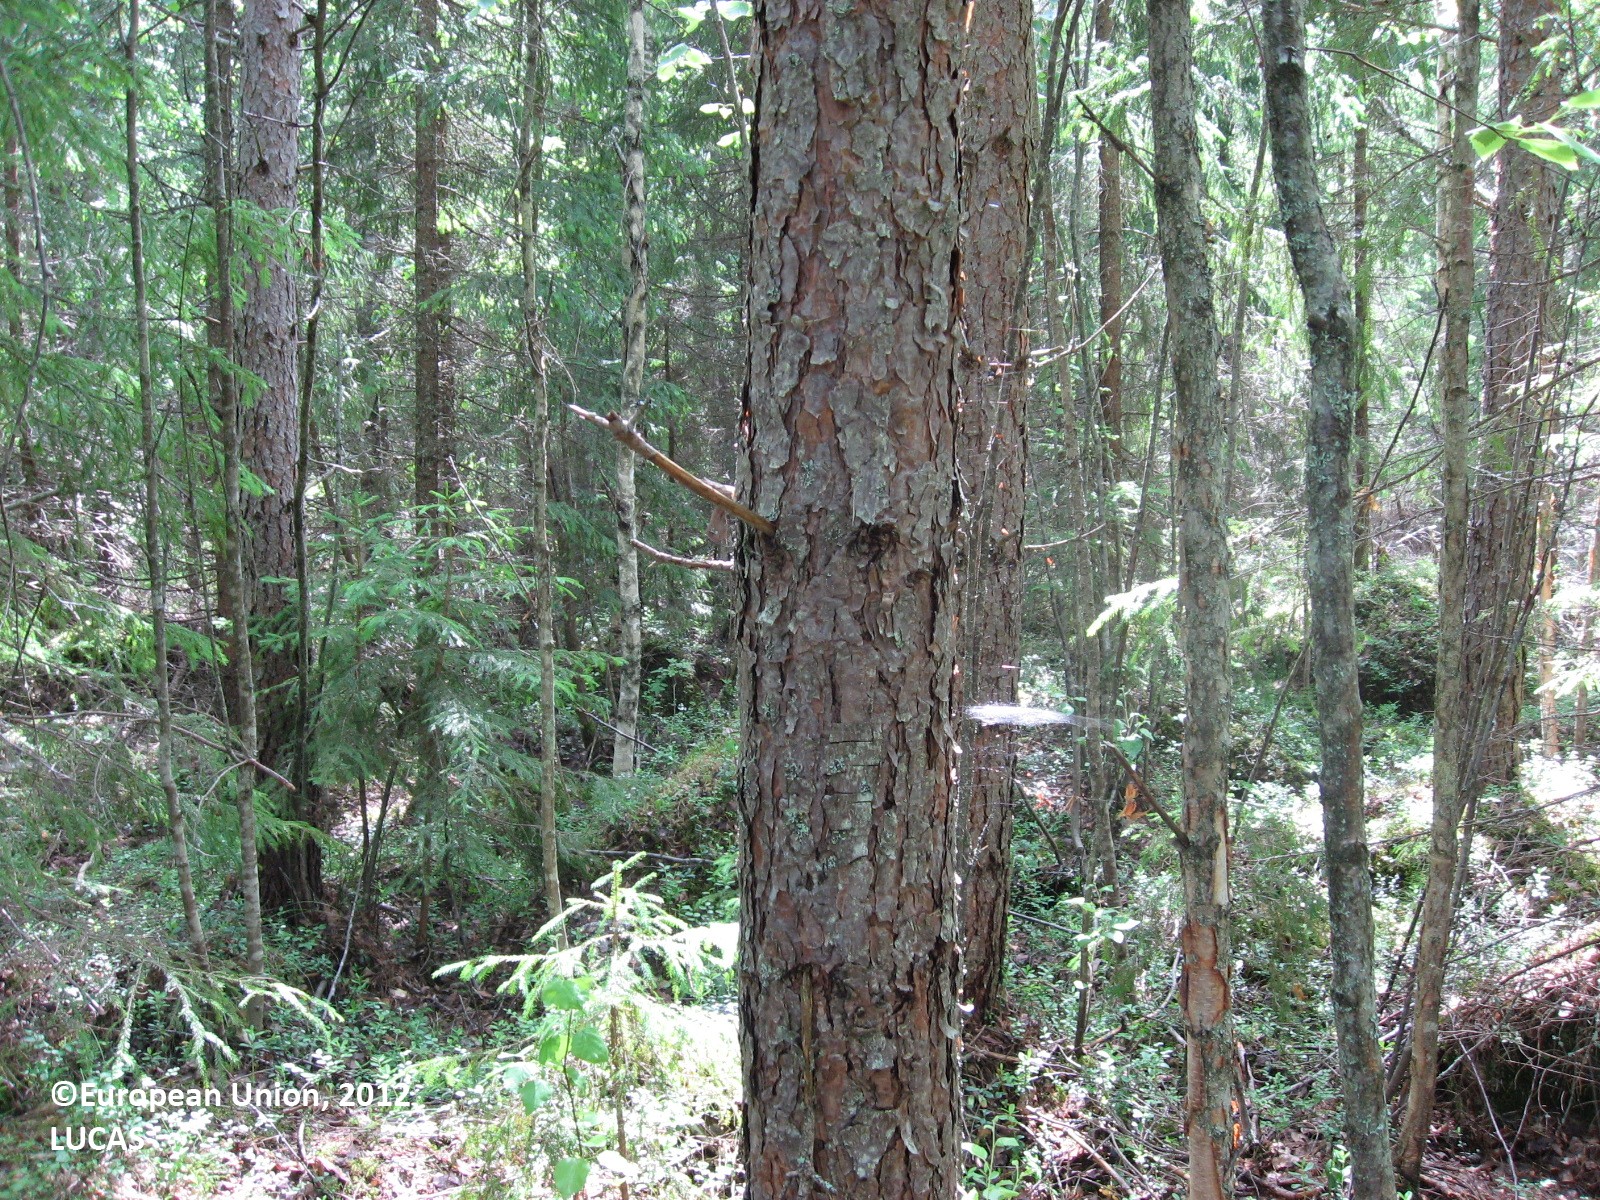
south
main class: Woodland
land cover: Spruce dominated mixed woodland
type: boreal forest
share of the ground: > 75 %
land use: Forestry
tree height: > 5 m
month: June
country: FI
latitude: 60.5522
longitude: 26.2875
